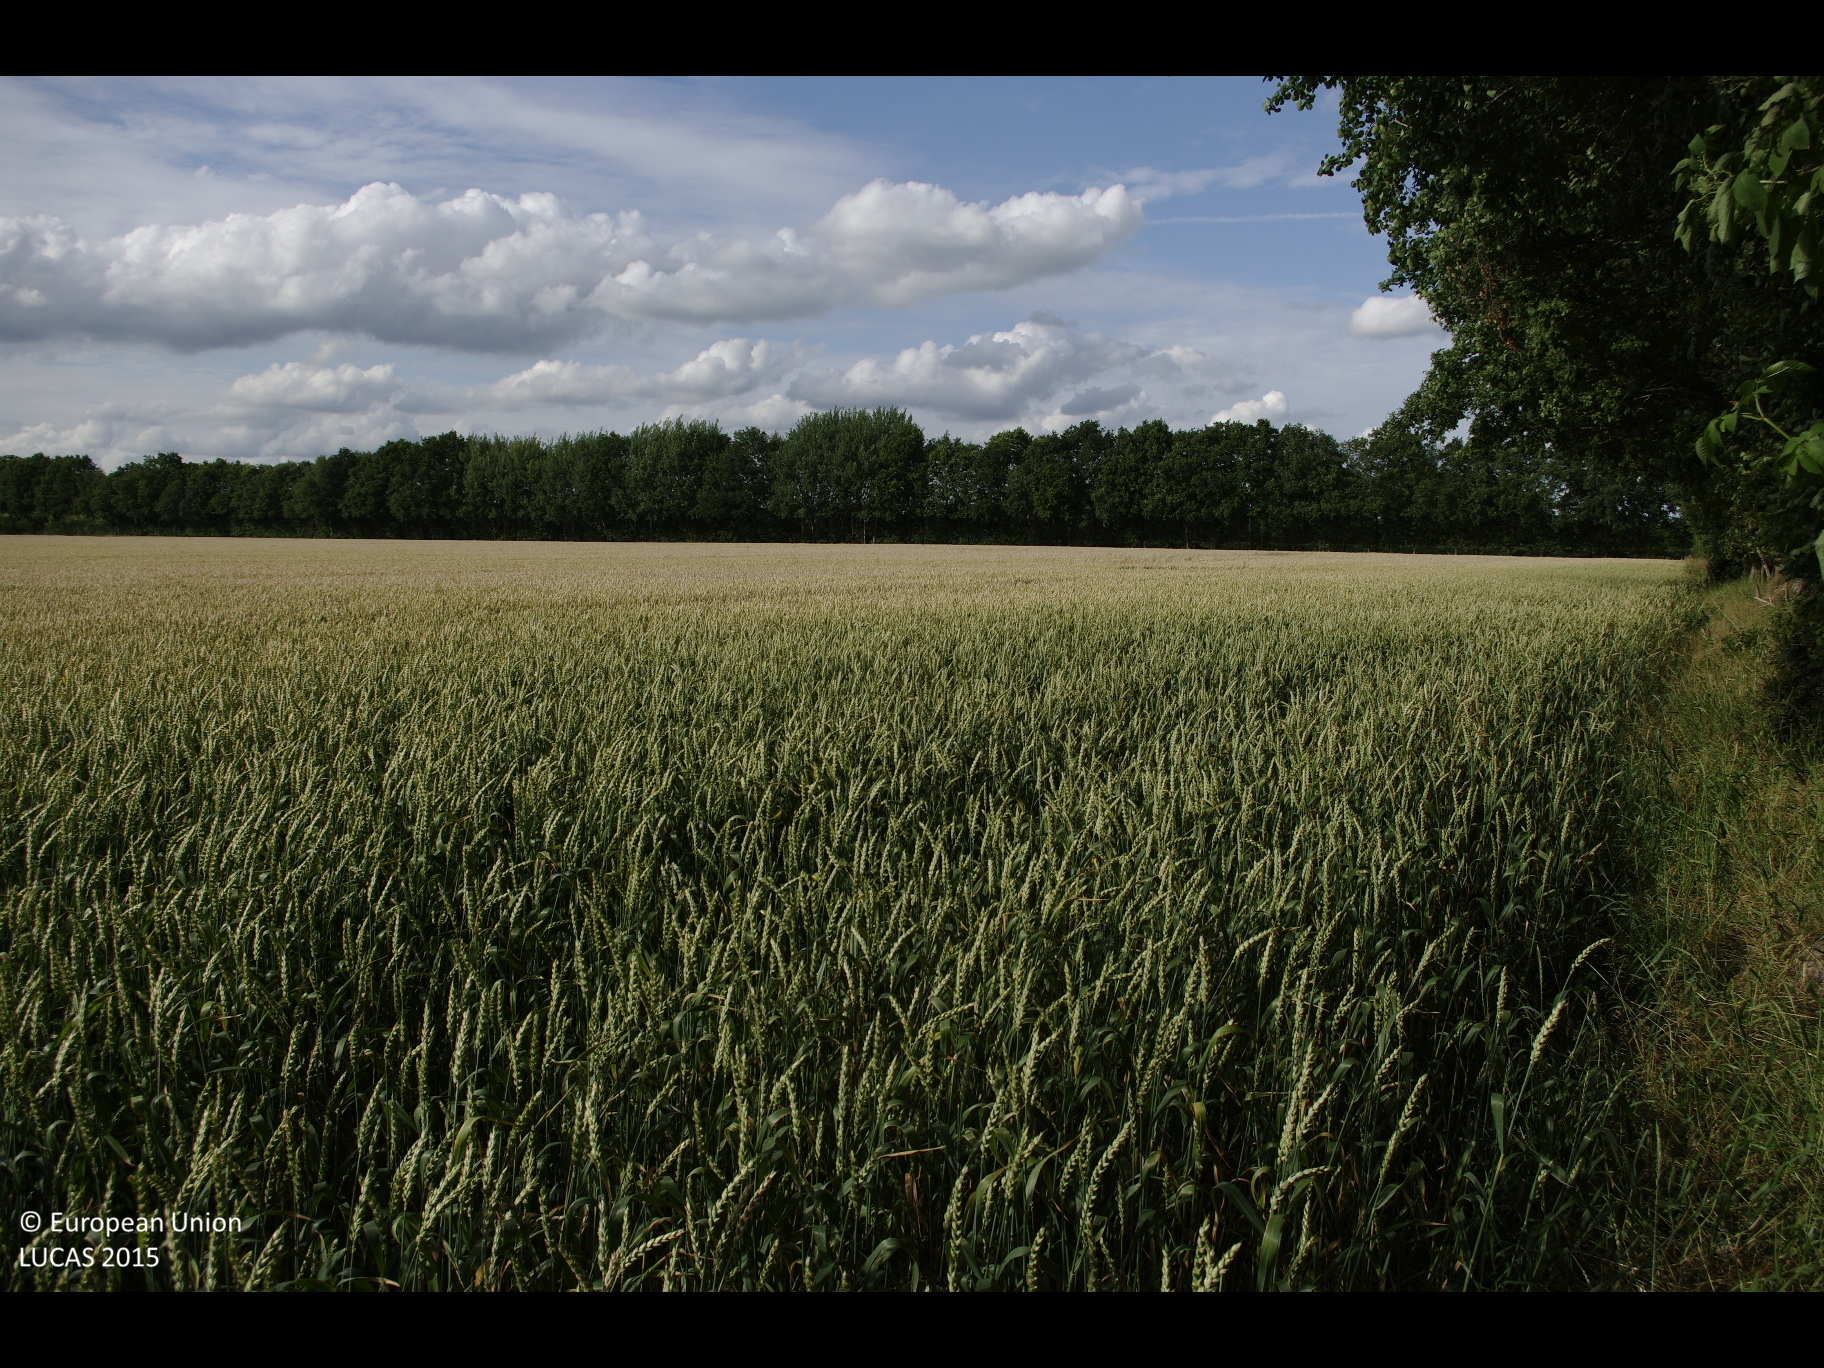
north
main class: Cropland
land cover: Common wheat
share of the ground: > 75 %
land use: Agriculture (excluding fallow land and kitchen gardens)
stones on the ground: < 10 %
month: July
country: DE
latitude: 53.9590
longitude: 9.9543
